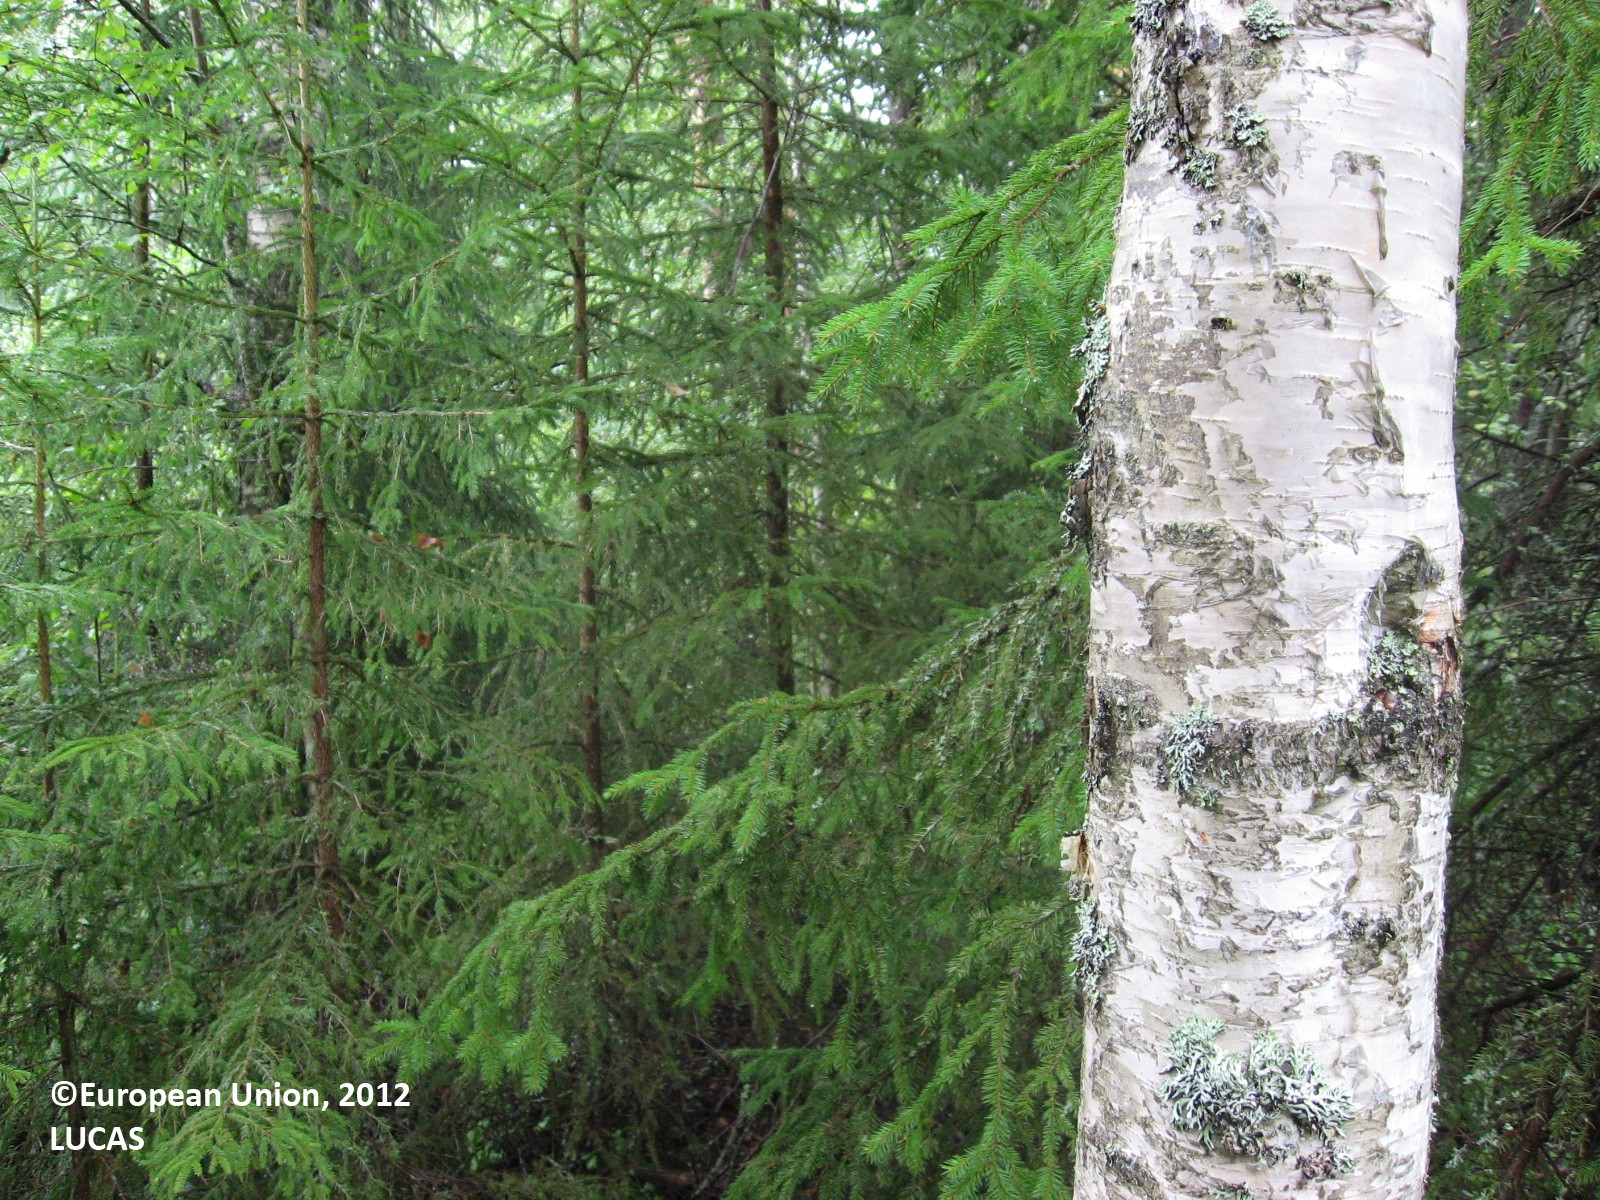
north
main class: Woodland
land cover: Spruce dominated mixed woodland
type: boreal forest
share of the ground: > 75 %
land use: Forestry
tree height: > 5 m
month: August
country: FI
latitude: 61.1080
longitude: 24.7460
